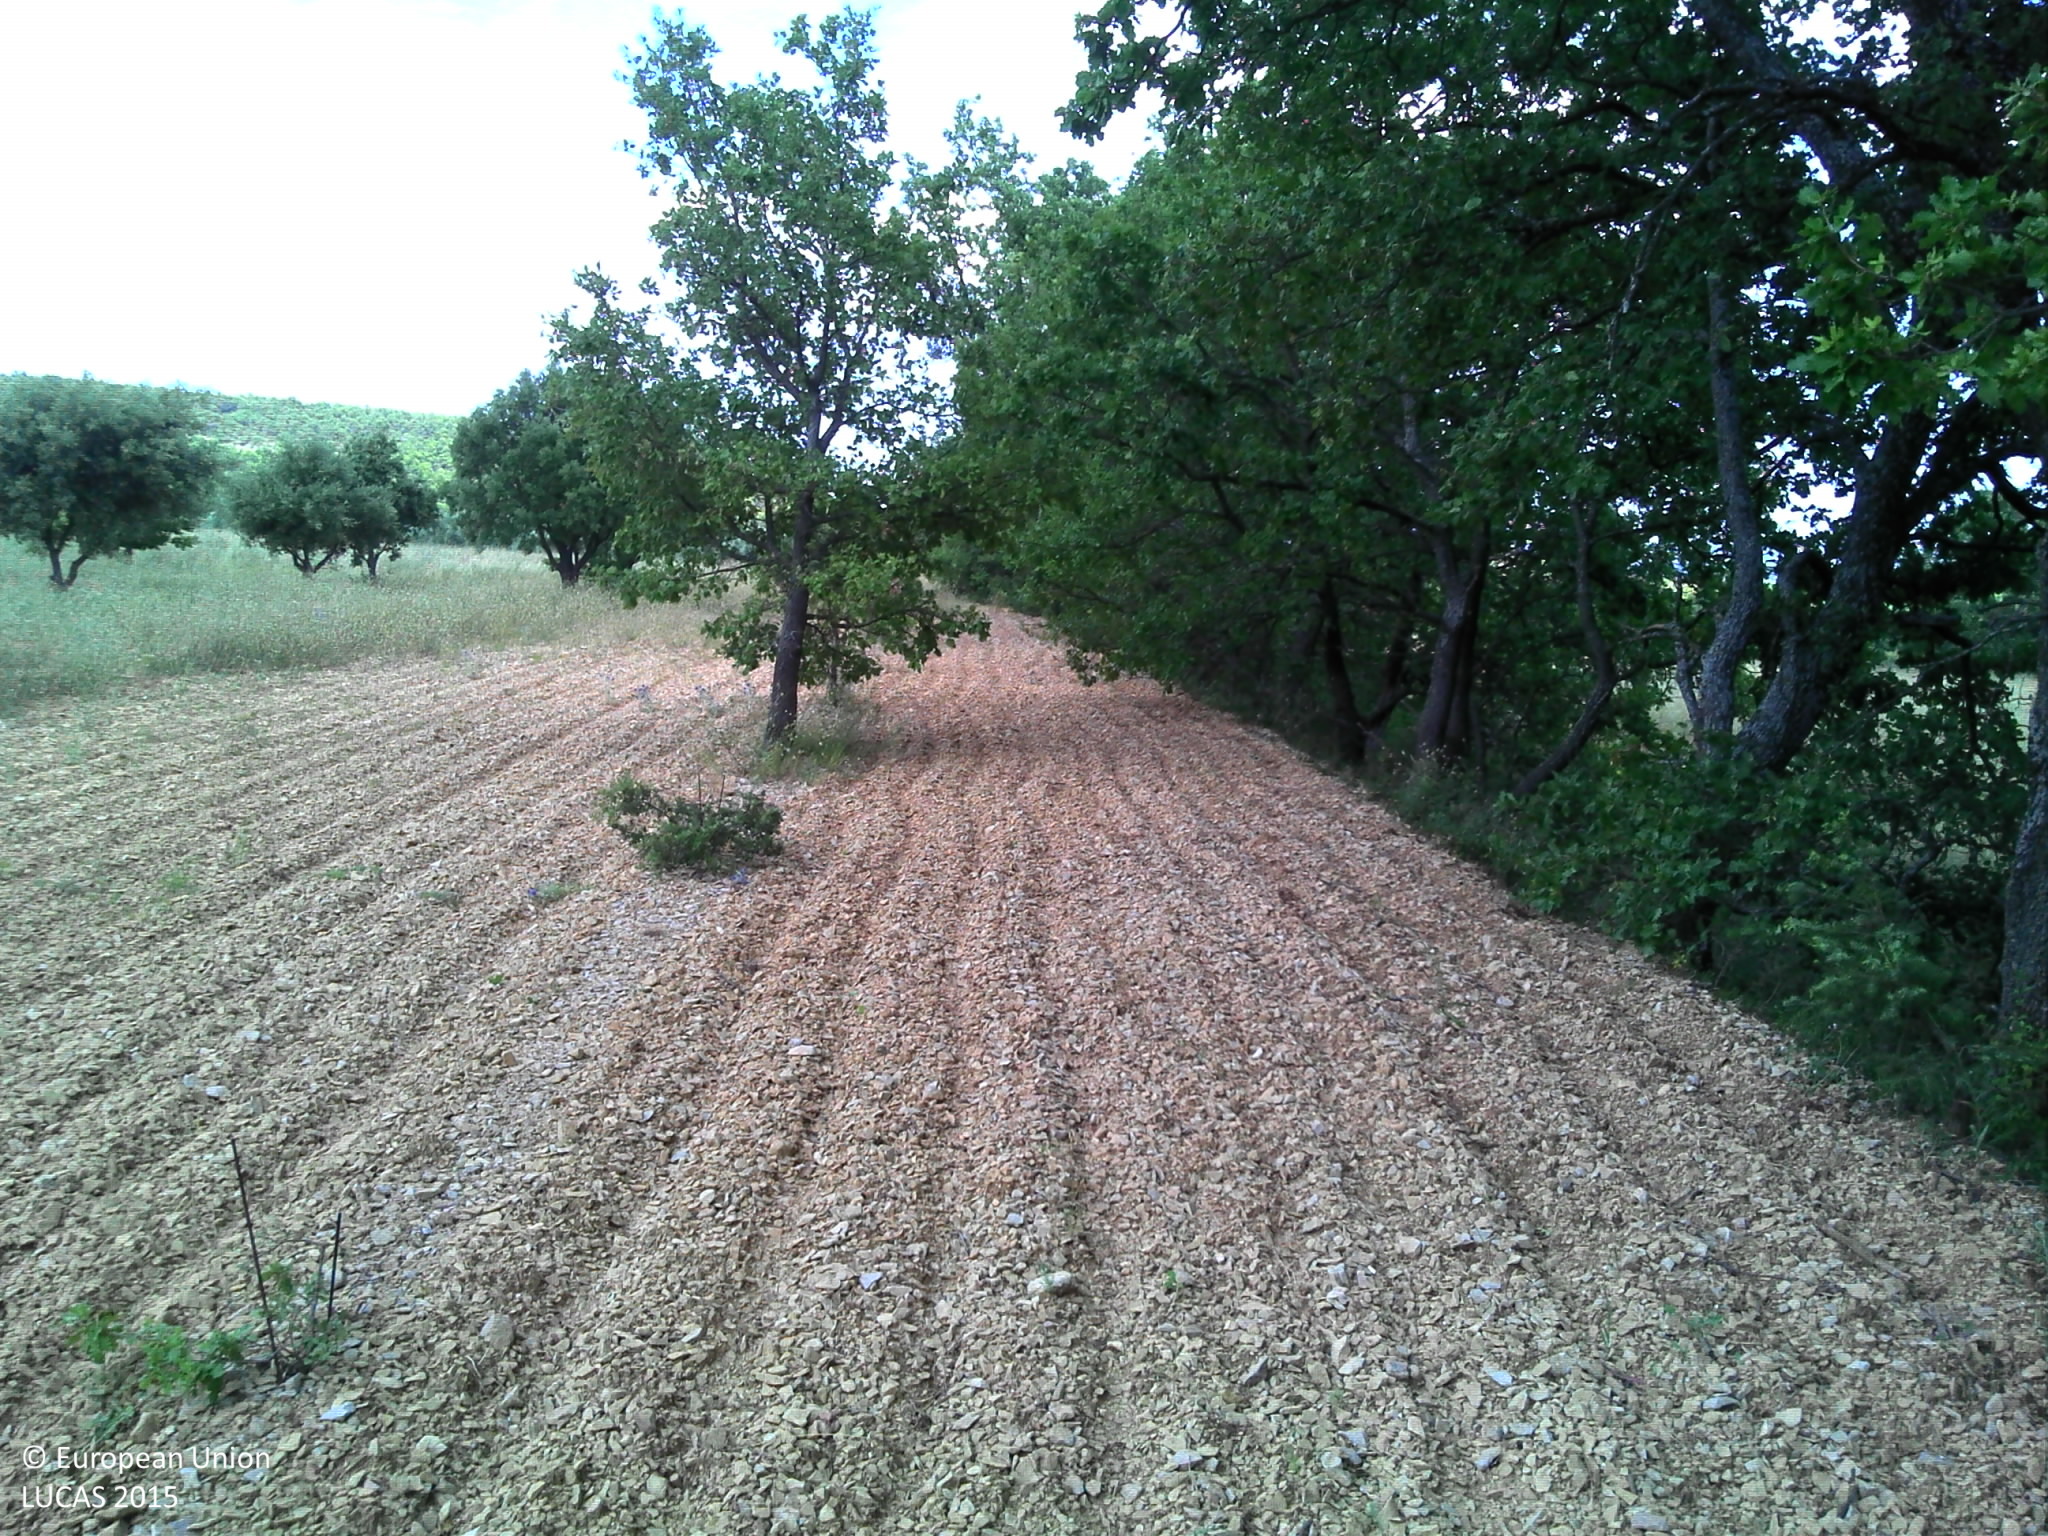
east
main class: Cropland
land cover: Other fresh vegetables
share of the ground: 25 - 50 %
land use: Agriculture (excluding fallow land and kitchen gardens)
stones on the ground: > 50 %
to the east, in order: Other fresh vegetables; Lines of trees; Grassland without tree/shrub cover; Vineyards; Abandoned hedges; Shrubland without tree cover; Shrubland with sparse tree cover
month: July
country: FR
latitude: 43.7799
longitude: 5.4241
